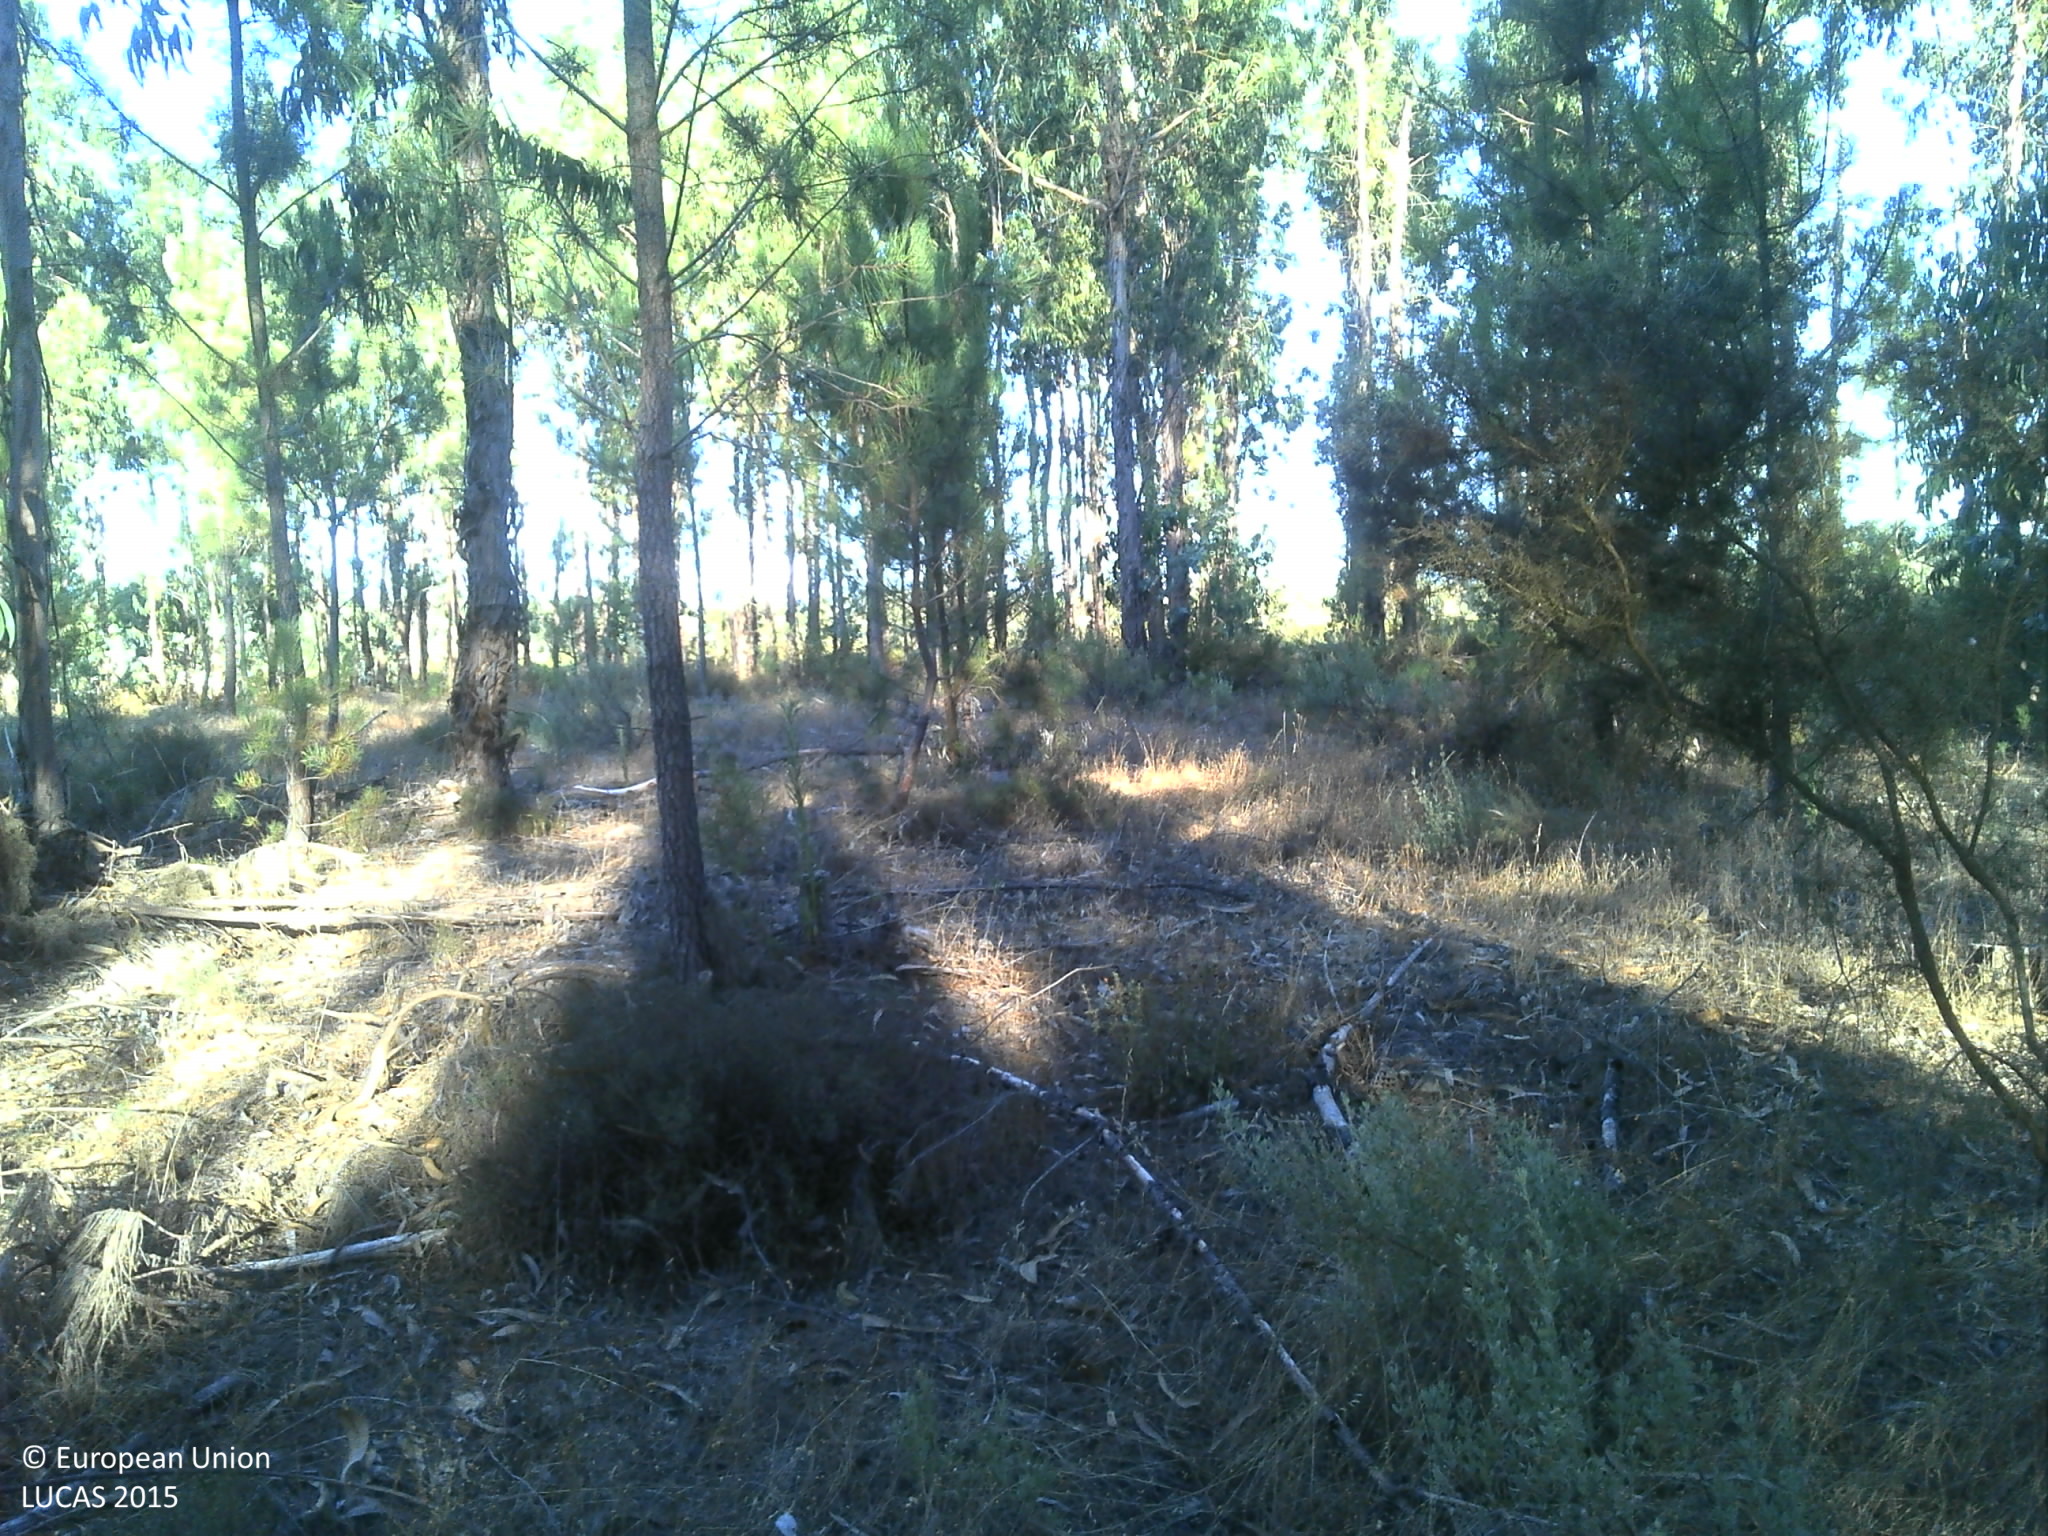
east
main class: Woodland
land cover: Pine dominated mixed woodland
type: coniferous forest of the mediterranean region
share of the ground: 25 - 50 %
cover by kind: coniferous forest trees 45 %, broadleaved forest trees 30 %, herbaceous plants 10 %, unconsolidated bare surface 10 %, shrubs 5 %
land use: Forestry
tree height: > 5 m
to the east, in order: Pine dominated mixed woodland; Tracks; Pine dominated mixed woodland; Spontaneously vegetated surfaces; Pine dominated coniferous woodland
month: July
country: PT
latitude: 39.0075
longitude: -8.6952
